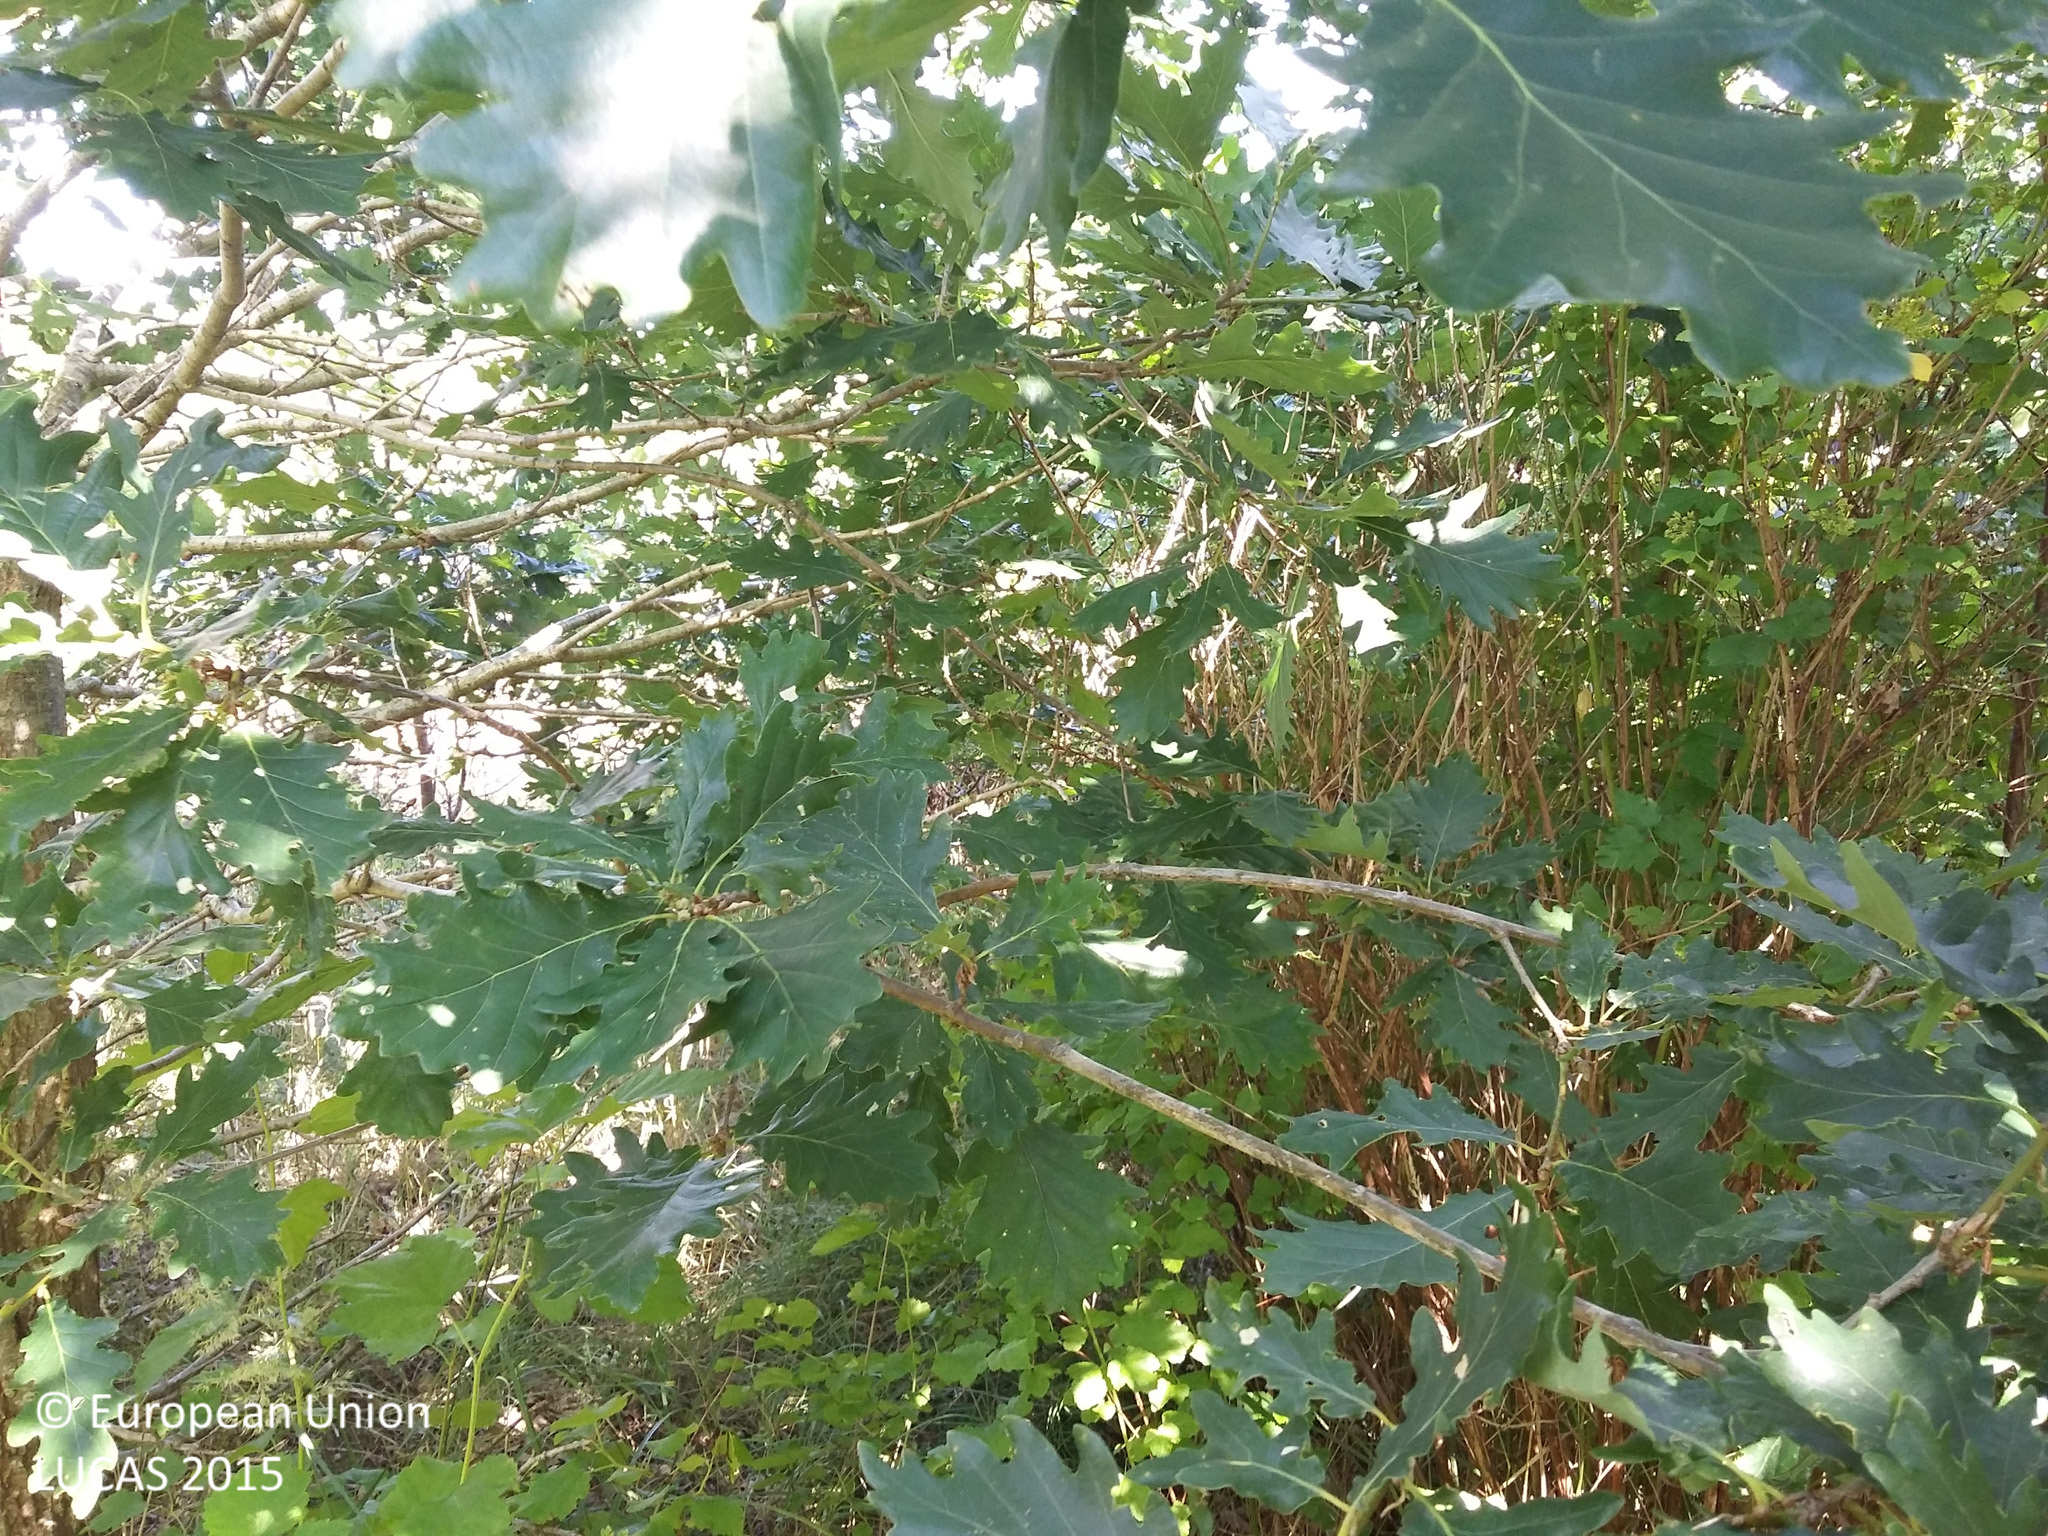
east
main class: Woodland
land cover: Broadleaved woodland
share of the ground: > 75 %
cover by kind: broadleaved forest trees 80 %, herbaceous plants 20 %
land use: Semi-natural and natural areas not in use
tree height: > 5 m
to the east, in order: Broadleaved woodland; Barley; Broadleaved woodland; Grassland without tree/shrub cover; Other mixed woodland
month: August
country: DK
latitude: 55.6849
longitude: 12.1136
